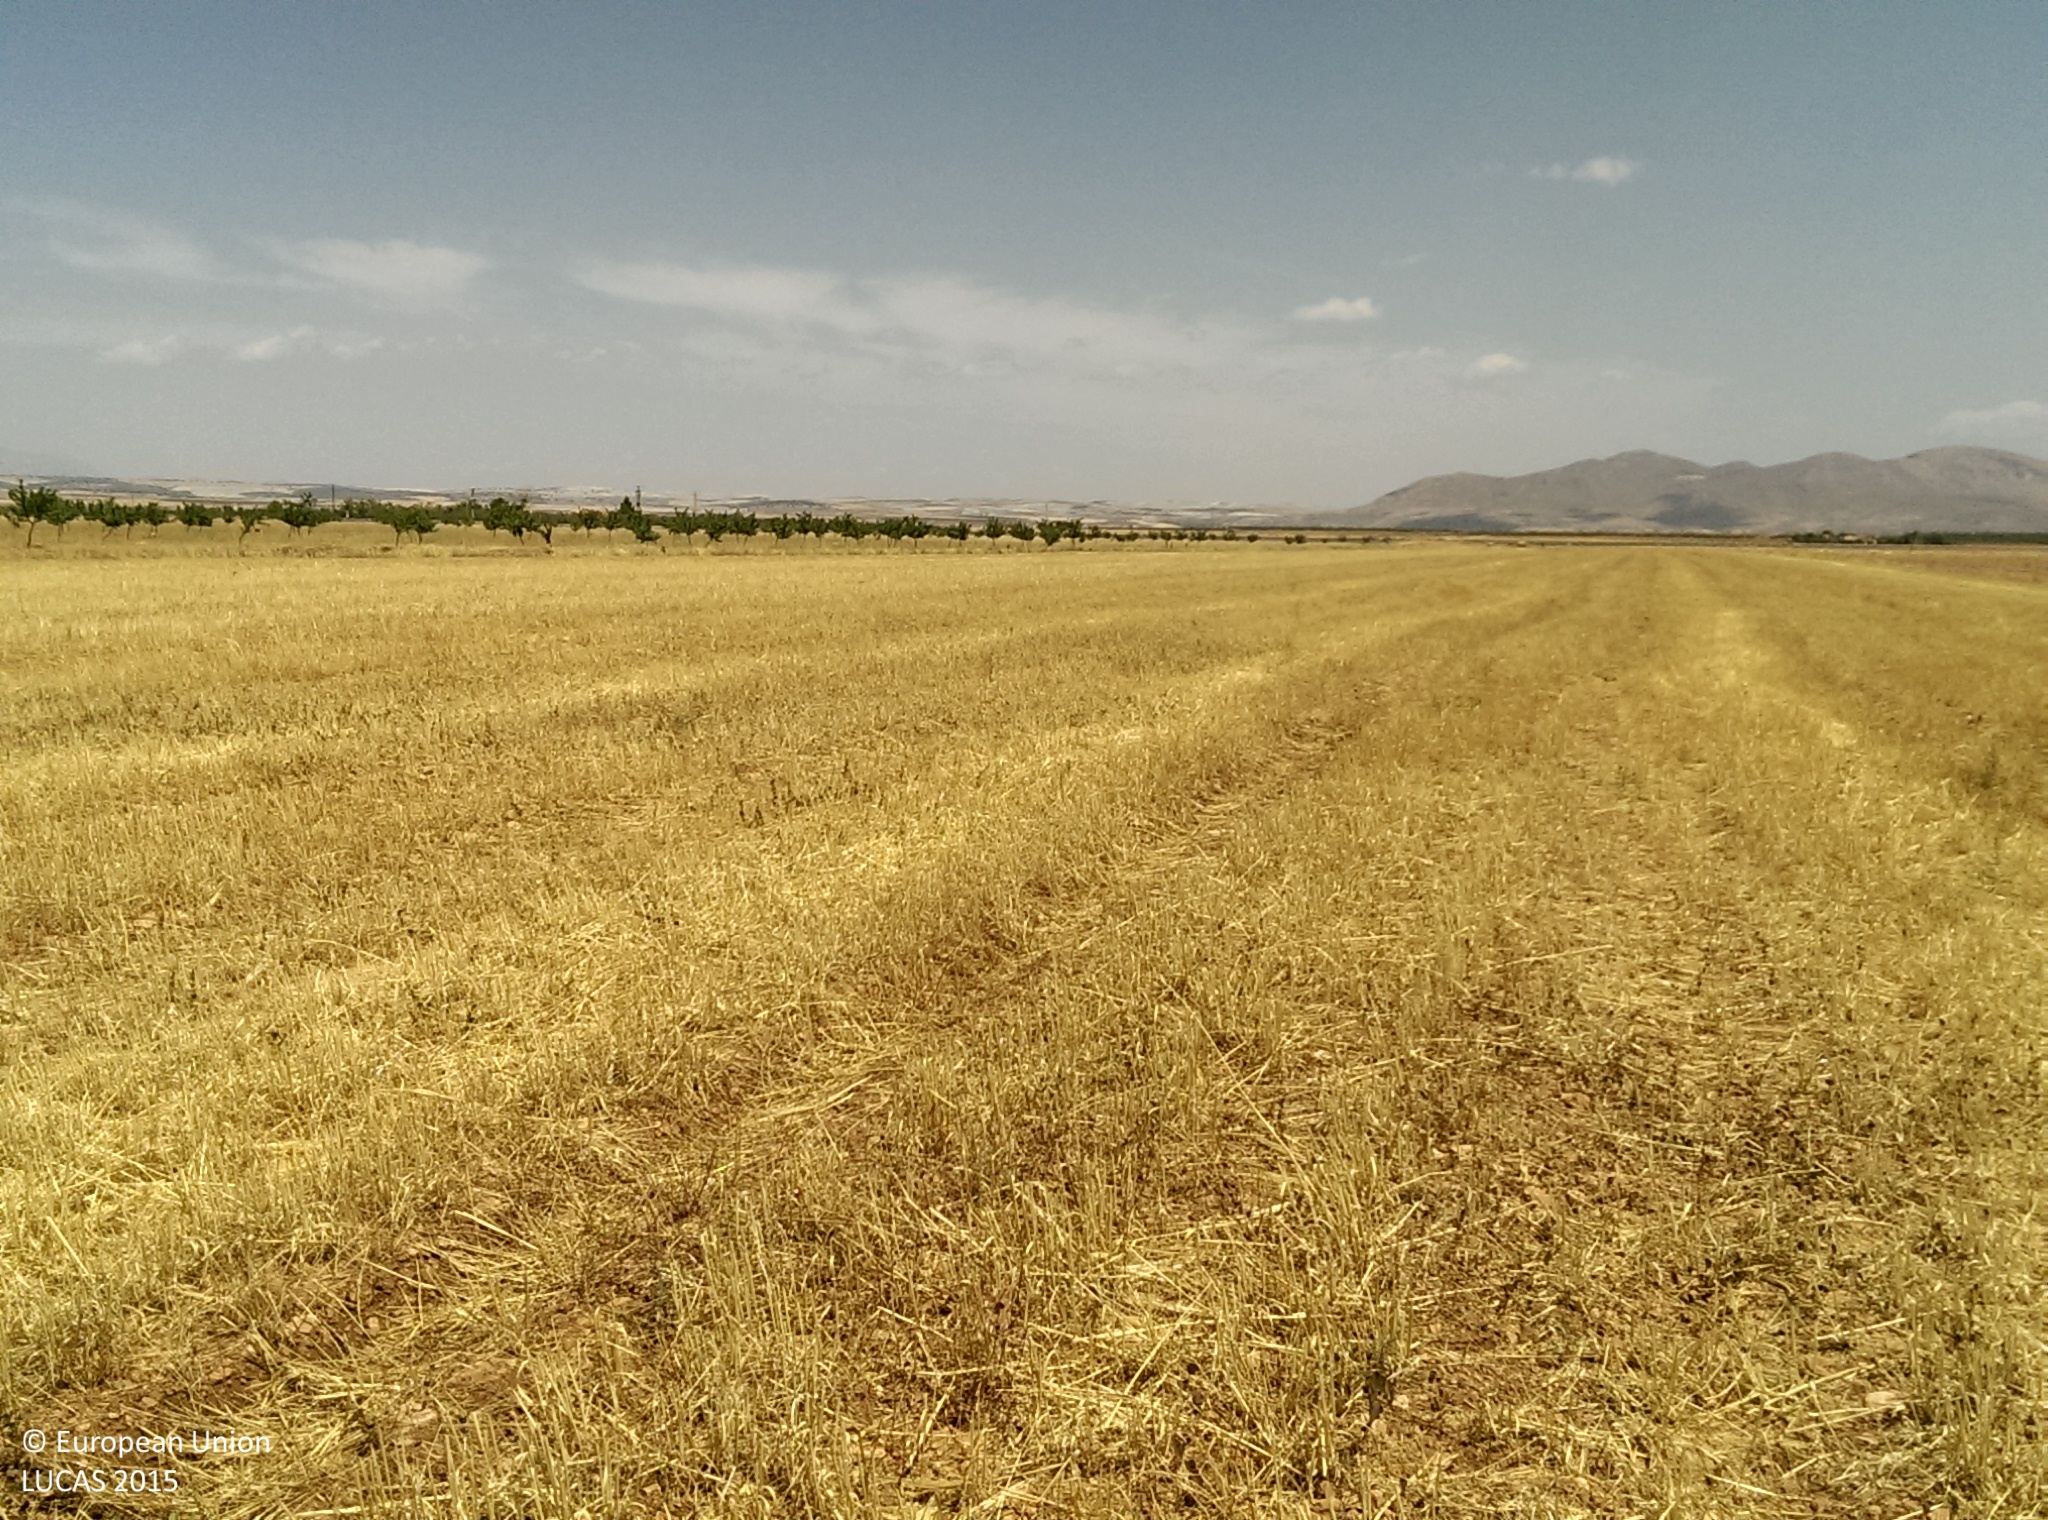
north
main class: Cropland
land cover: Barley
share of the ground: < 10 %
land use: Agriculture (excluding fallow land and kitchen gardens)
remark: Harvested field
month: July
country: ES
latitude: 37.4044
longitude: -3.2411
